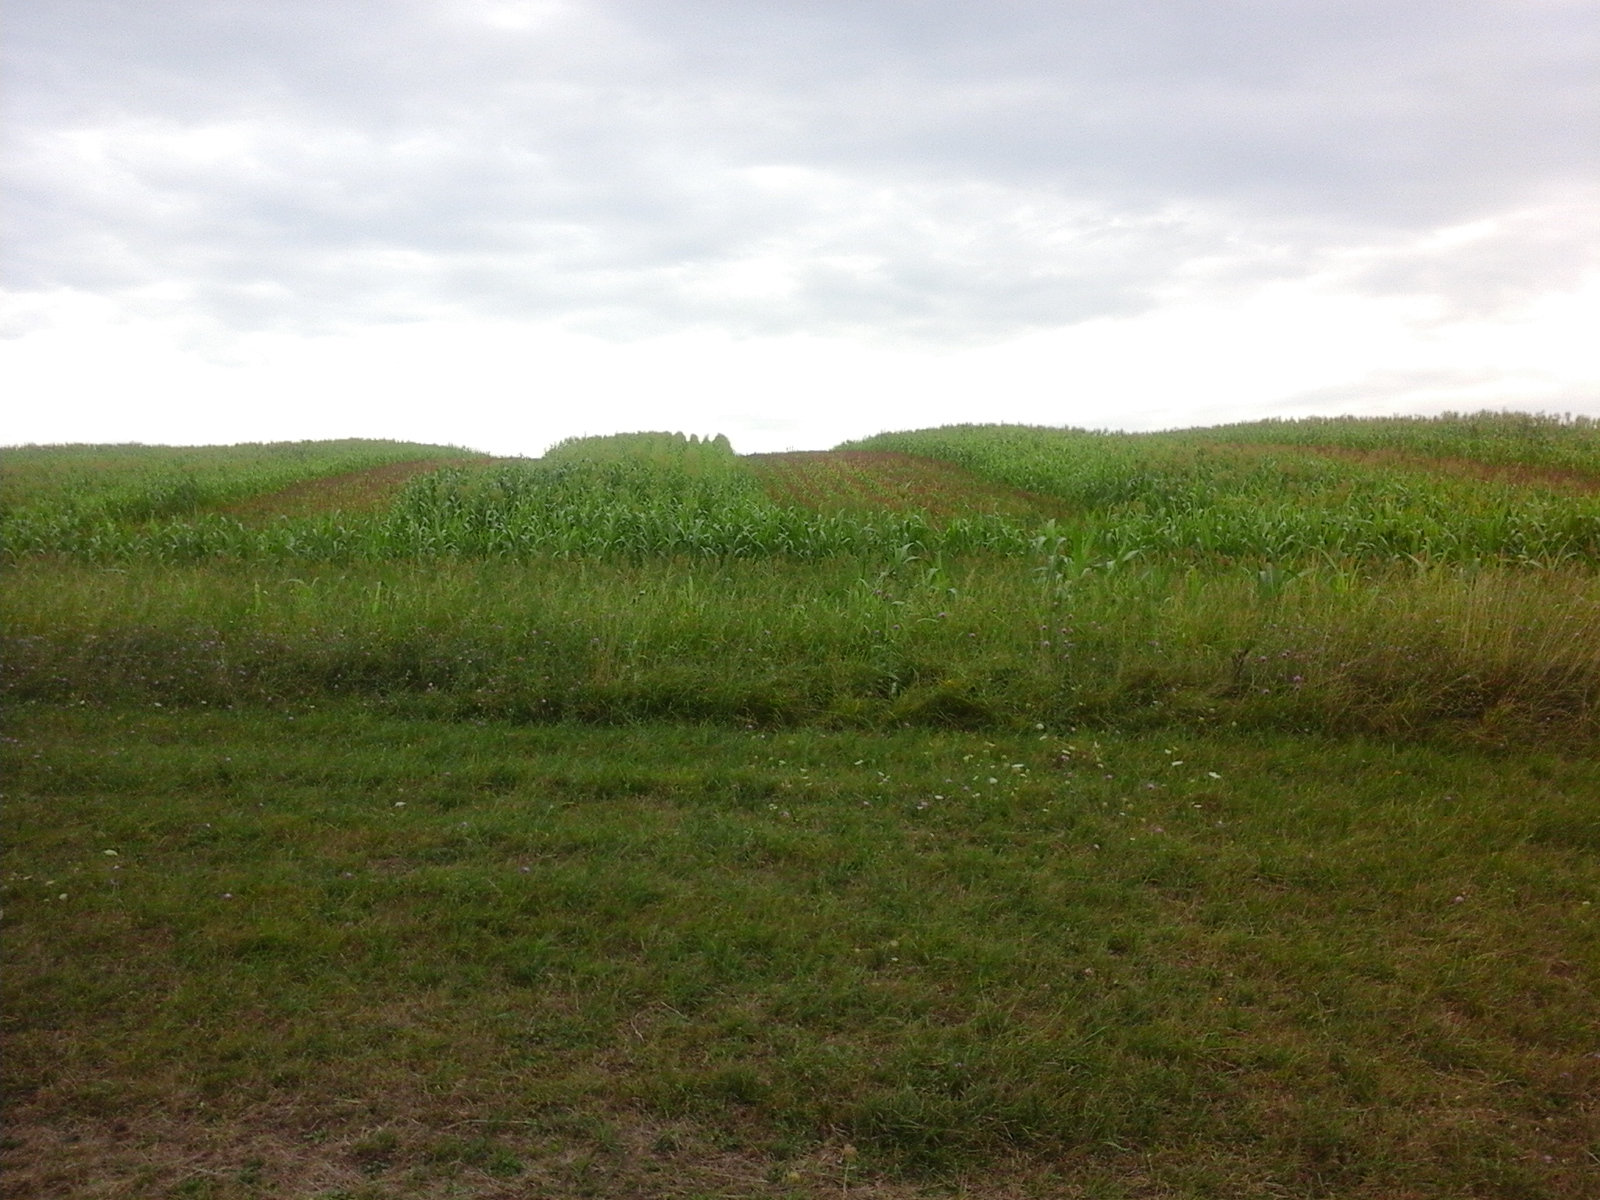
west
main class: Grassland
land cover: Grassland without tree/shrub cover
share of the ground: > 75 %
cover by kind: herbaceous plants 100 %
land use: Agriculture (excluding fallow land and kitchen gardens)
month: August
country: RO
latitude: 45.5172
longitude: 21.4378
